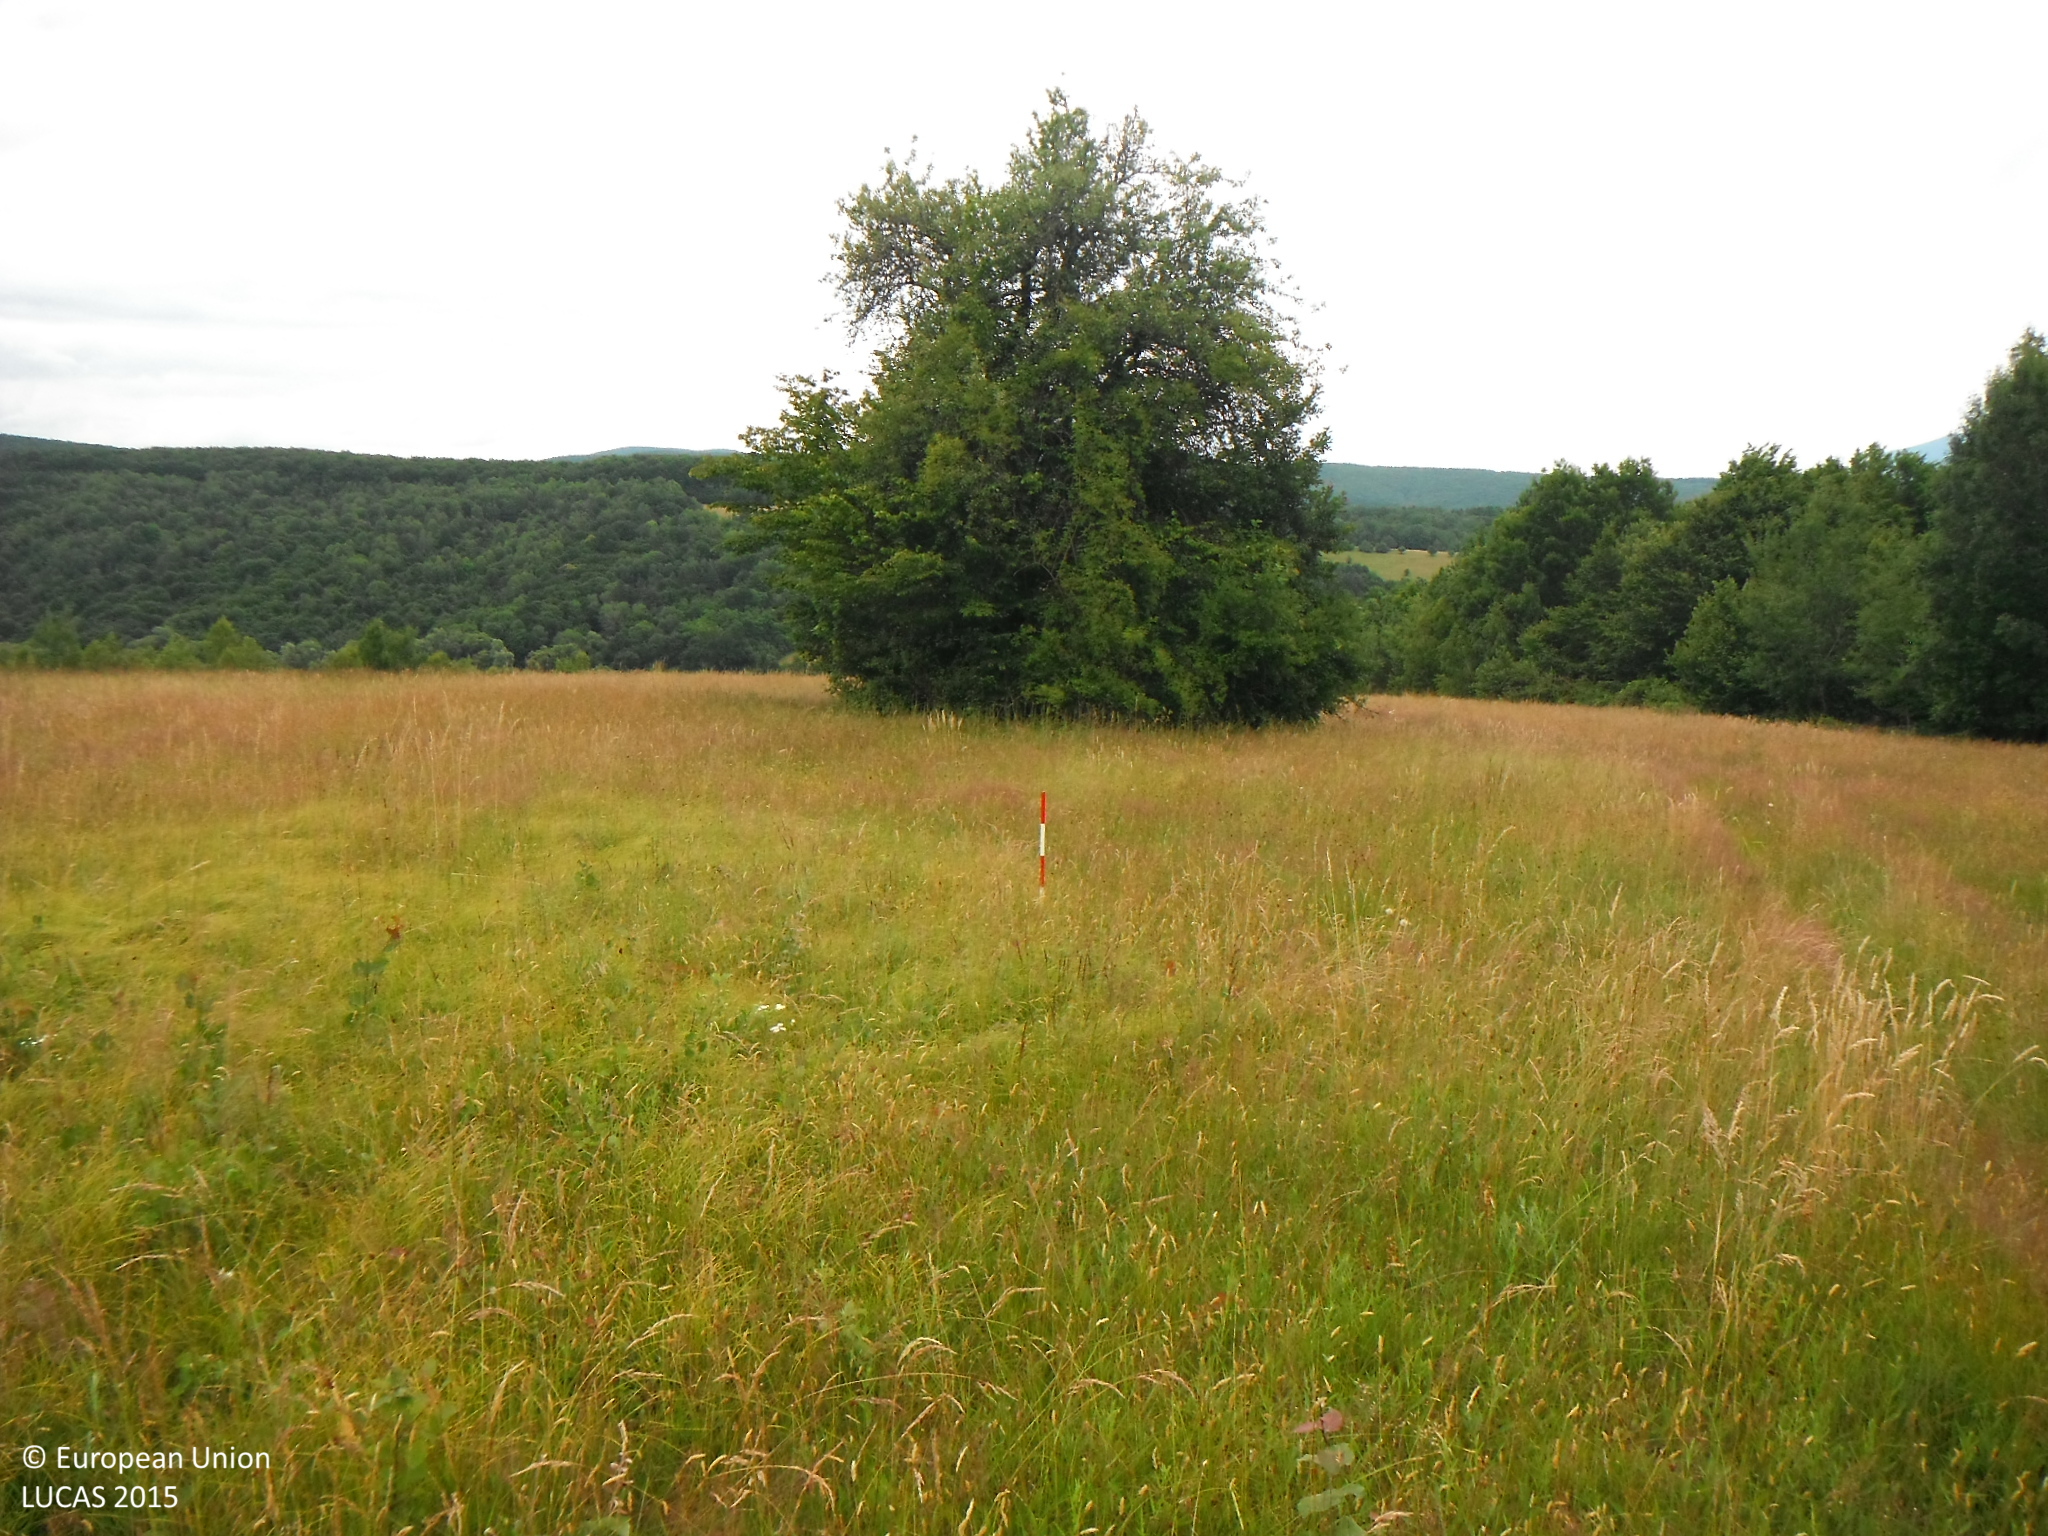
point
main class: Grassland
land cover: Grassland without tree/shrub cover
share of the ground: > 75 %
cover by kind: herbaceous plants 100 %
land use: Agriculture (excluding fallow land and kitchen gardens)
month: June
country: SK
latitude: 49.0034
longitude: 21.9891
